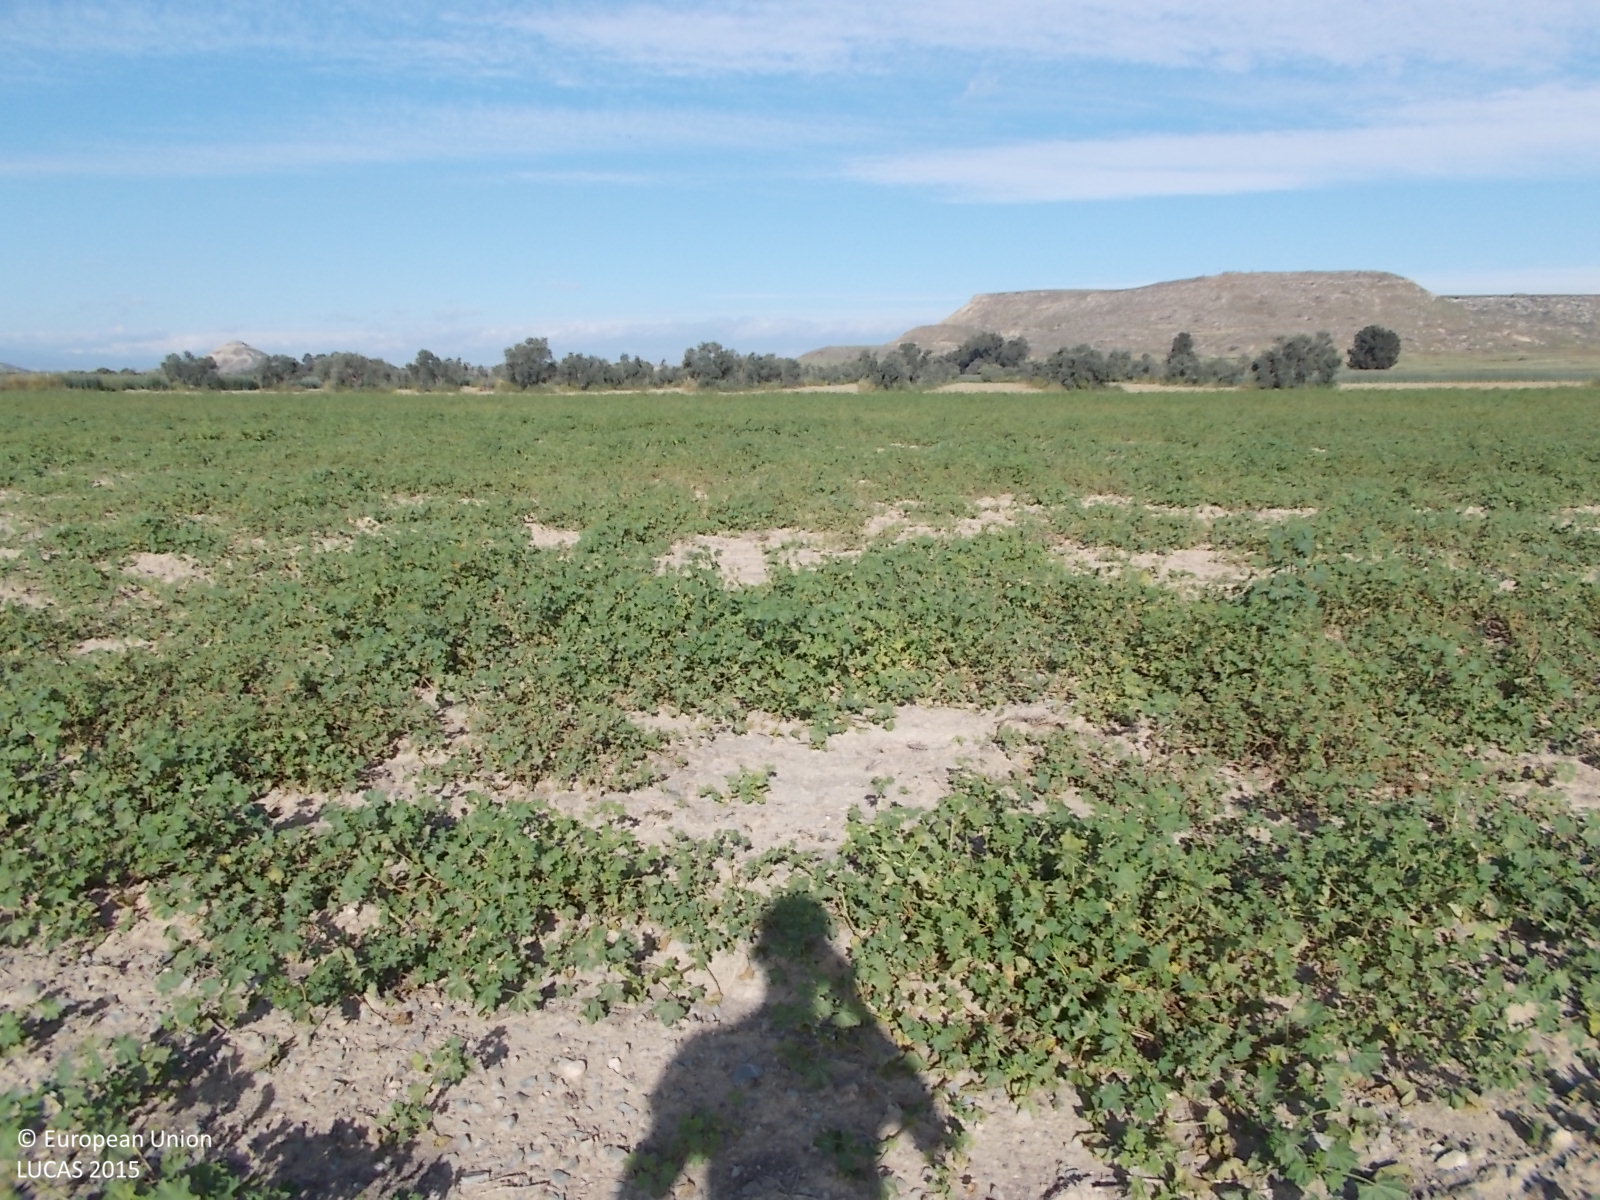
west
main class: Cropland
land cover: Other fresh vegetables
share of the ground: 50 - 75 %
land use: Agriculture (excluding fallow land and kitchen gardens)
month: April
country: CY
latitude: 35.0717
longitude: 33.5227
